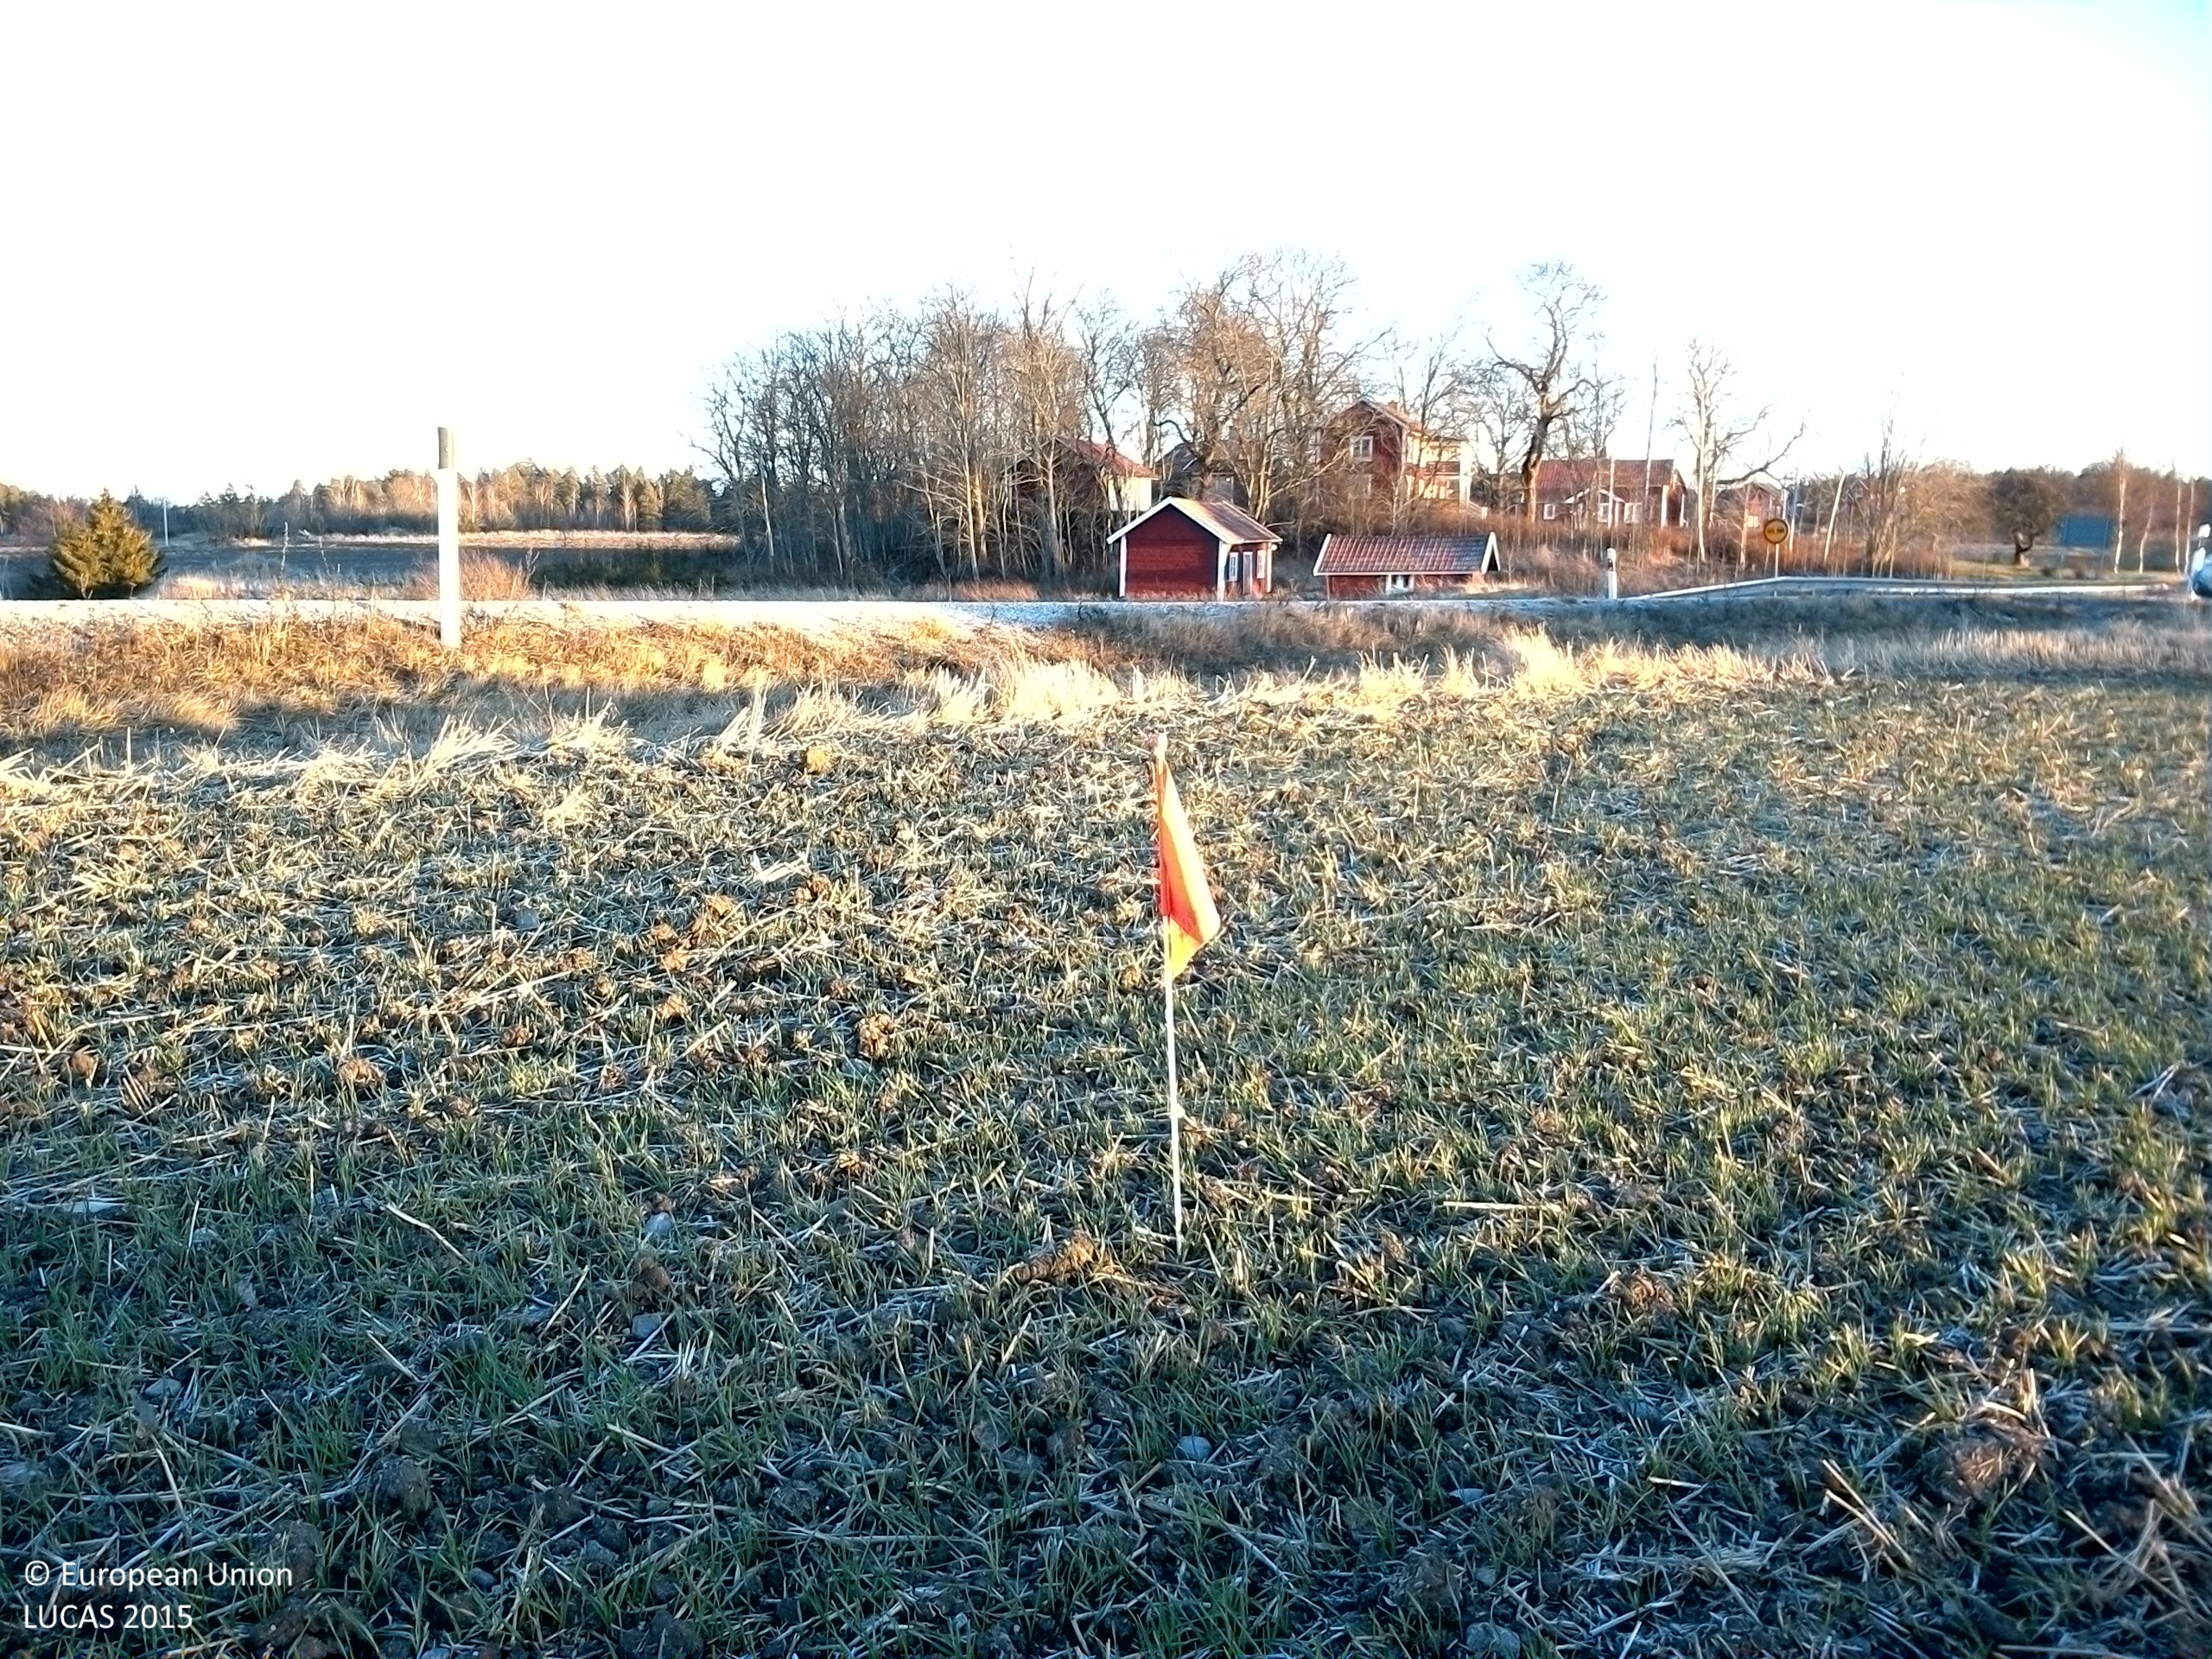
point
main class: Cropland
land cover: Common wheat
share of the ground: > 75 %
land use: Agriculture (excluding fallow land and kitchen gardens)
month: December
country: SE
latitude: 59.2882
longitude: 16.5412
